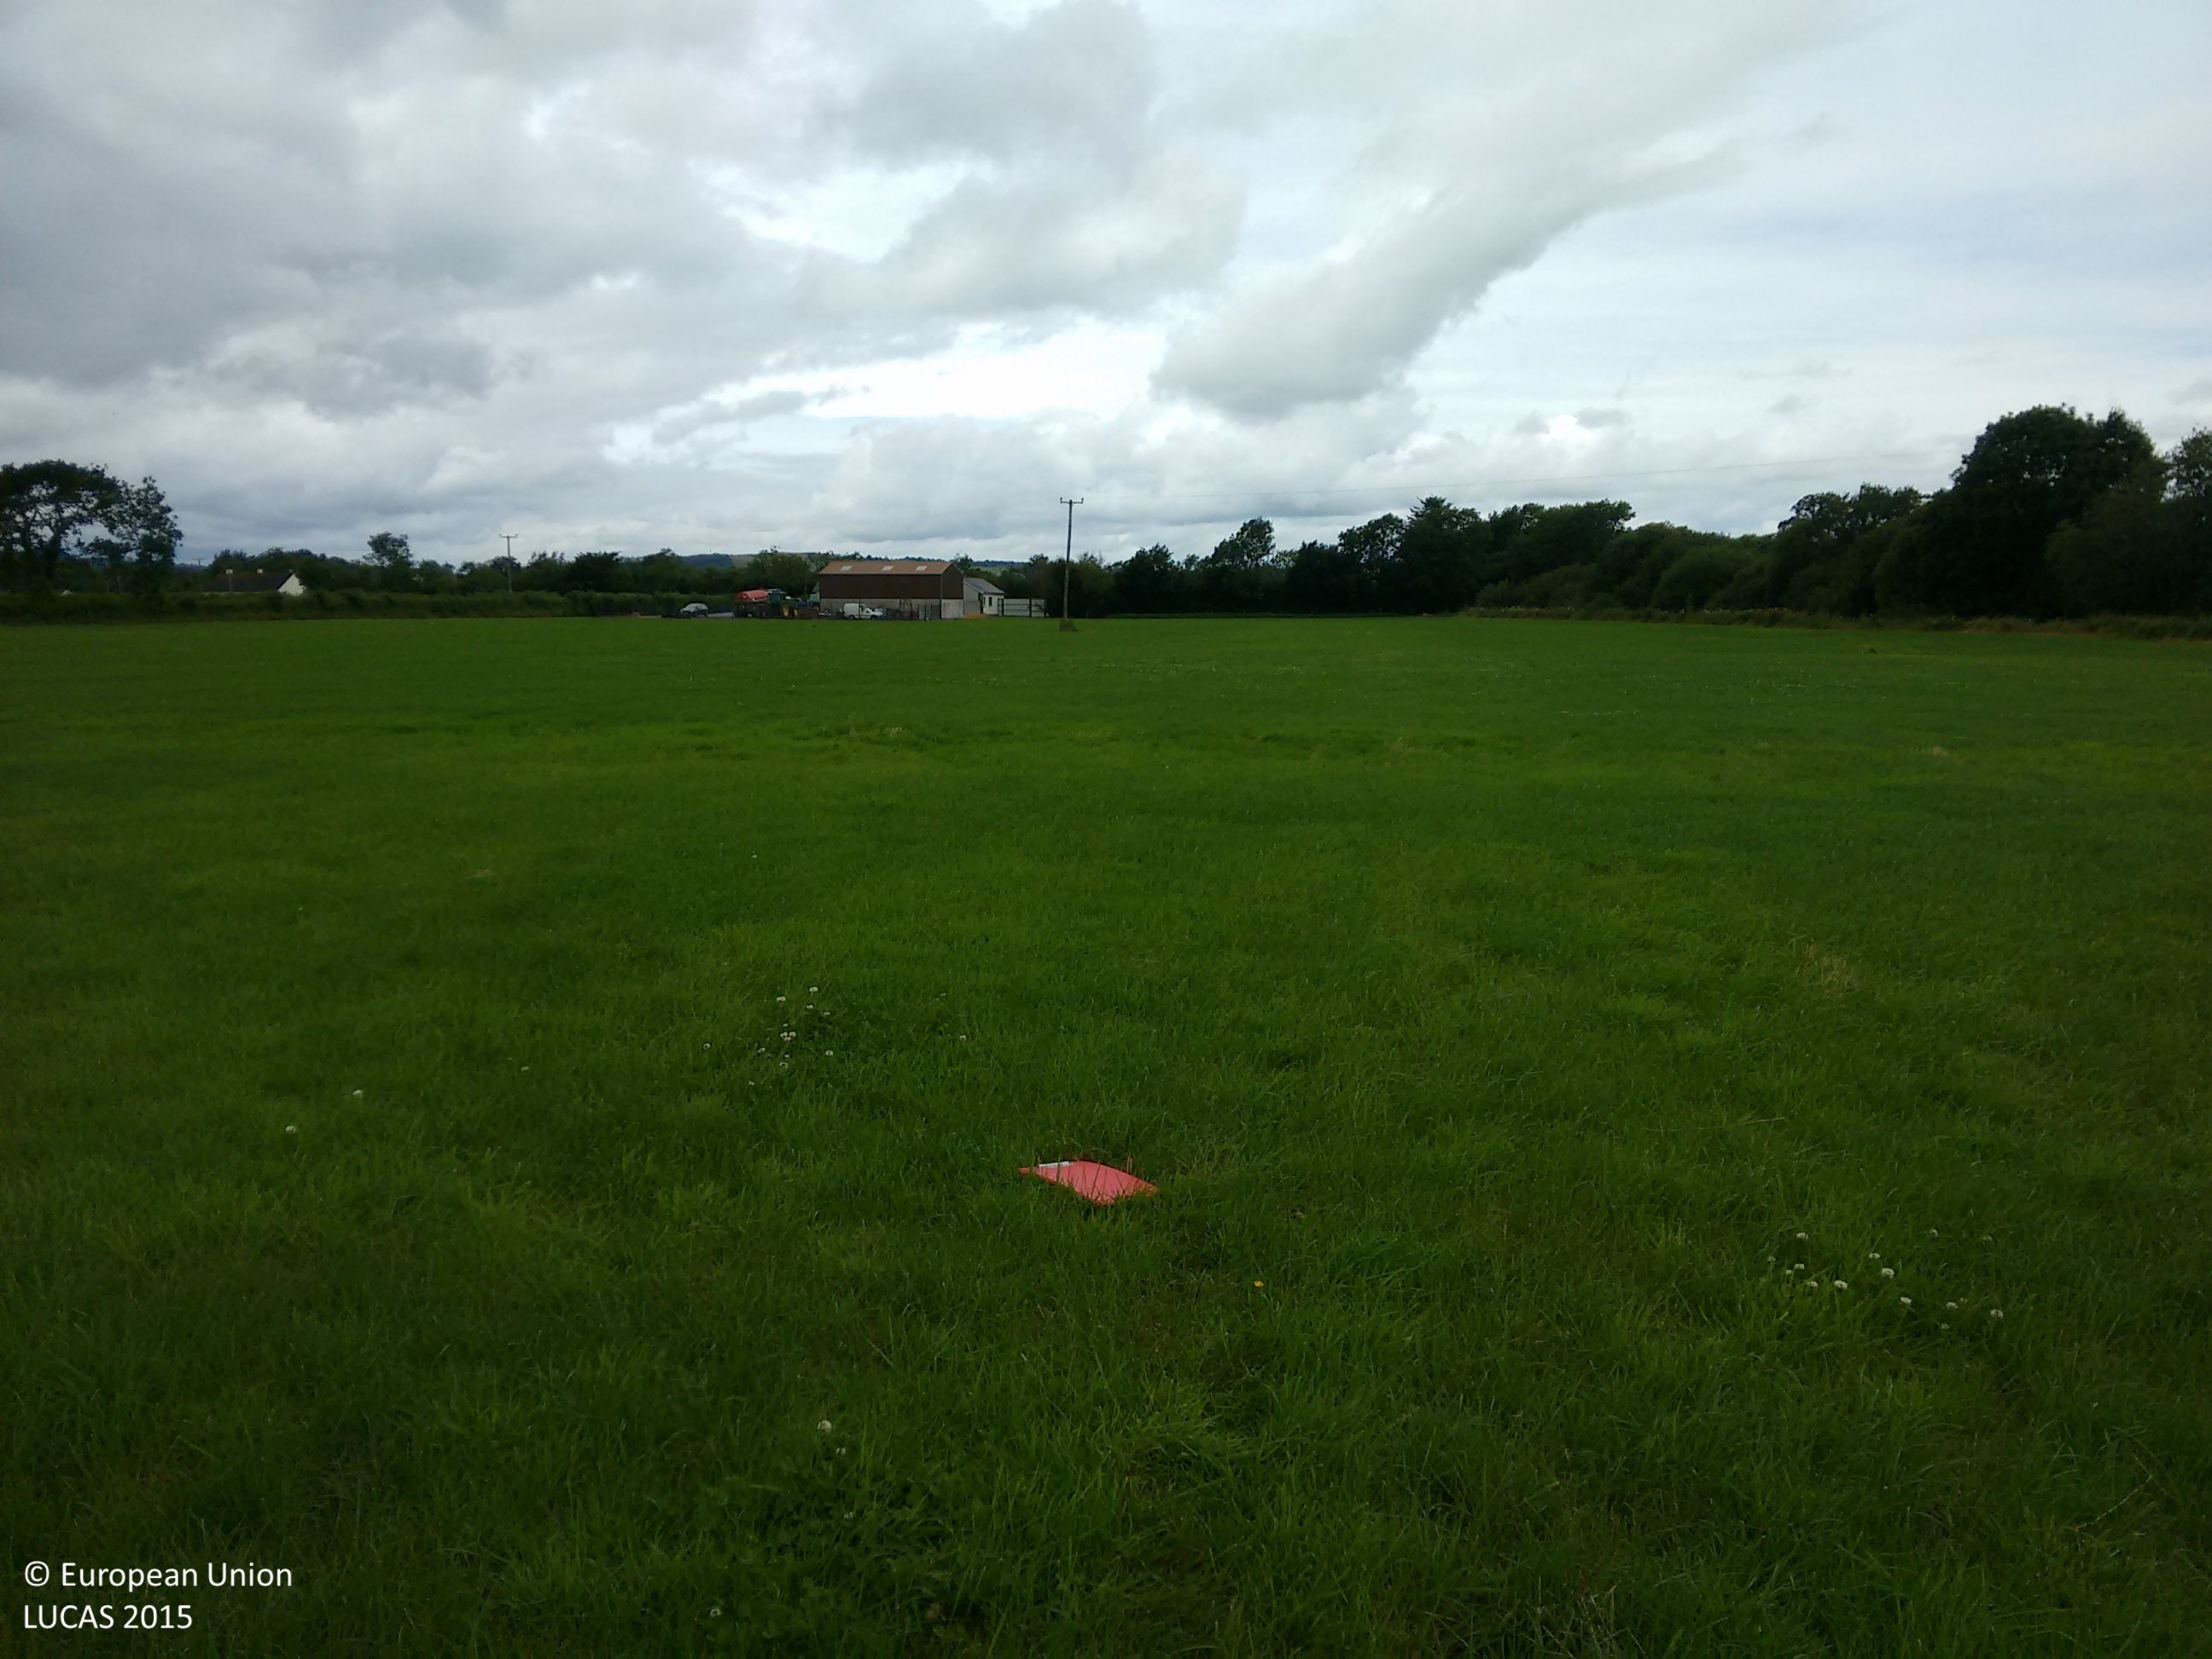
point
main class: Grassland
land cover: Grassland without tree/shrub cover
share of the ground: > 75 %
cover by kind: herbaceous plants 100 %
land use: Agriculture (excluding fallow land and kitchen gardens)
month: July
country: IE
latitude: 52.6384
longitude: -7.3091
